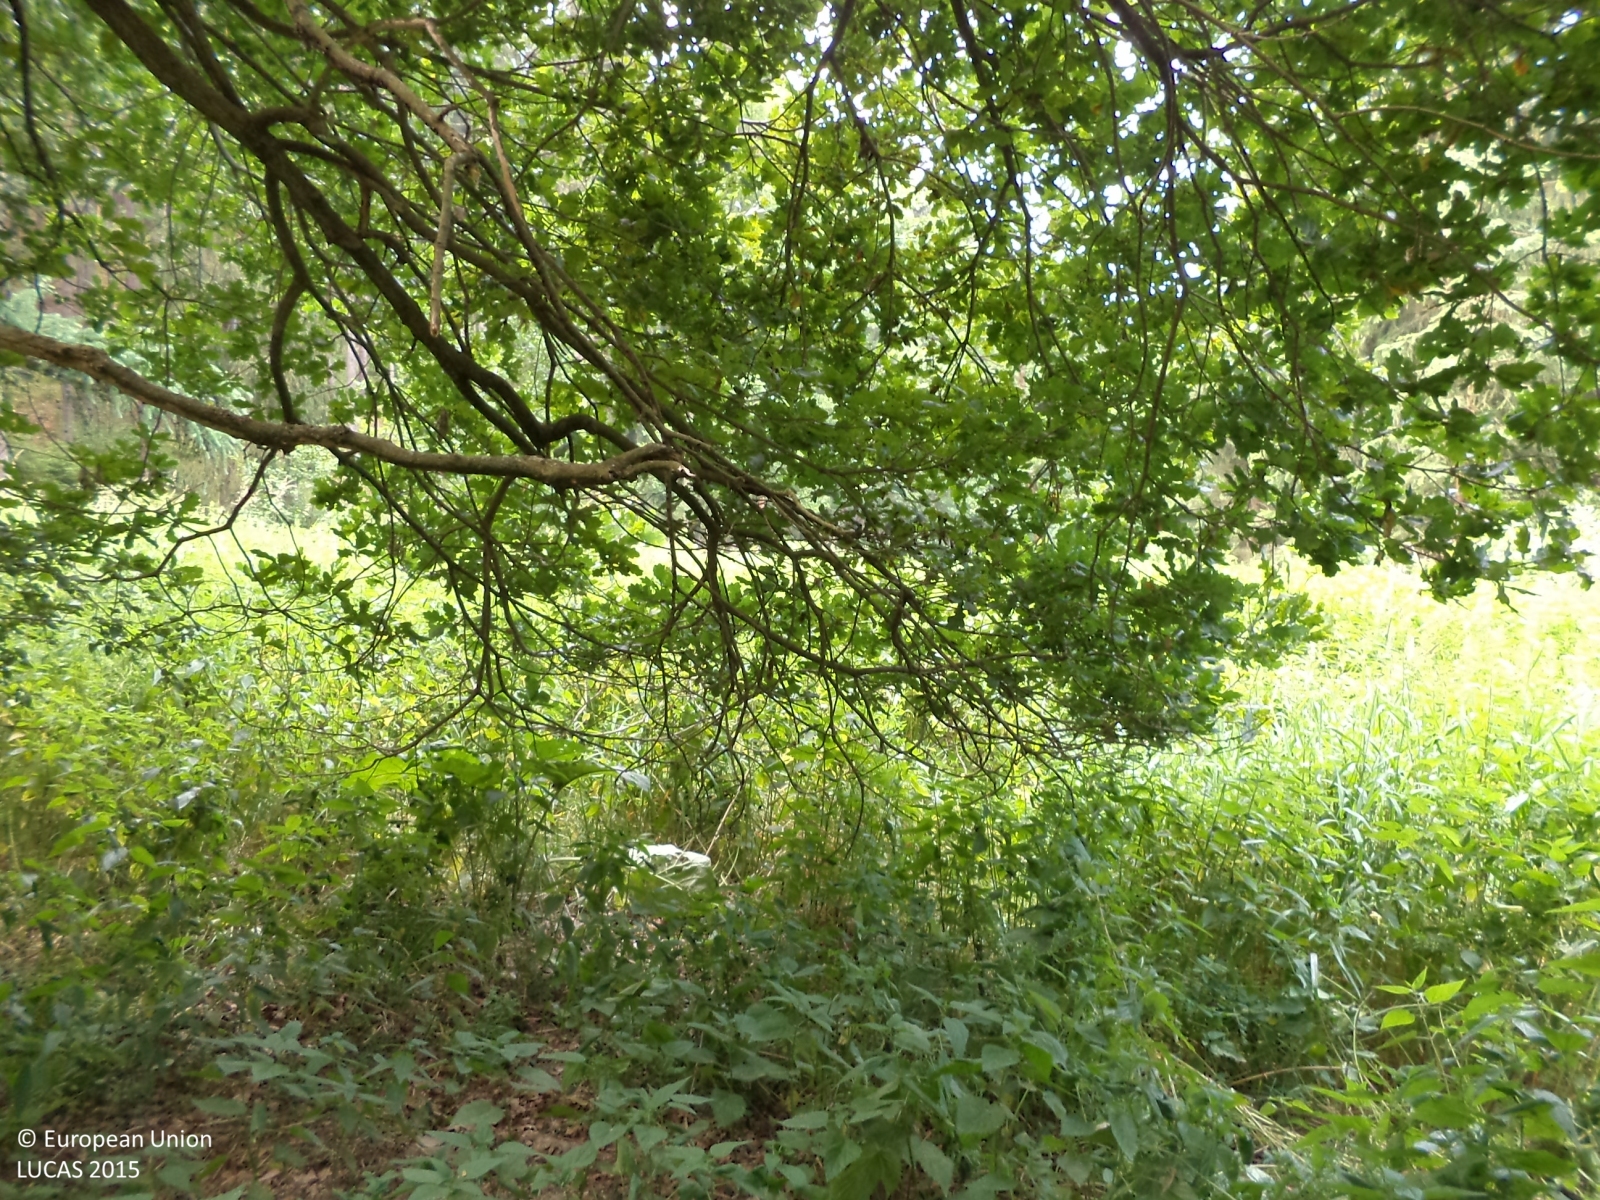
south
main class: Grassland
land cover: Grassland without tree/shrub cover
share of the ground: > 75 %
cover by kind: herbaceous plants 100 %
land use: Forestry
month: July
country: CZ
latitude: 49.3949
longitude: 14.4518
